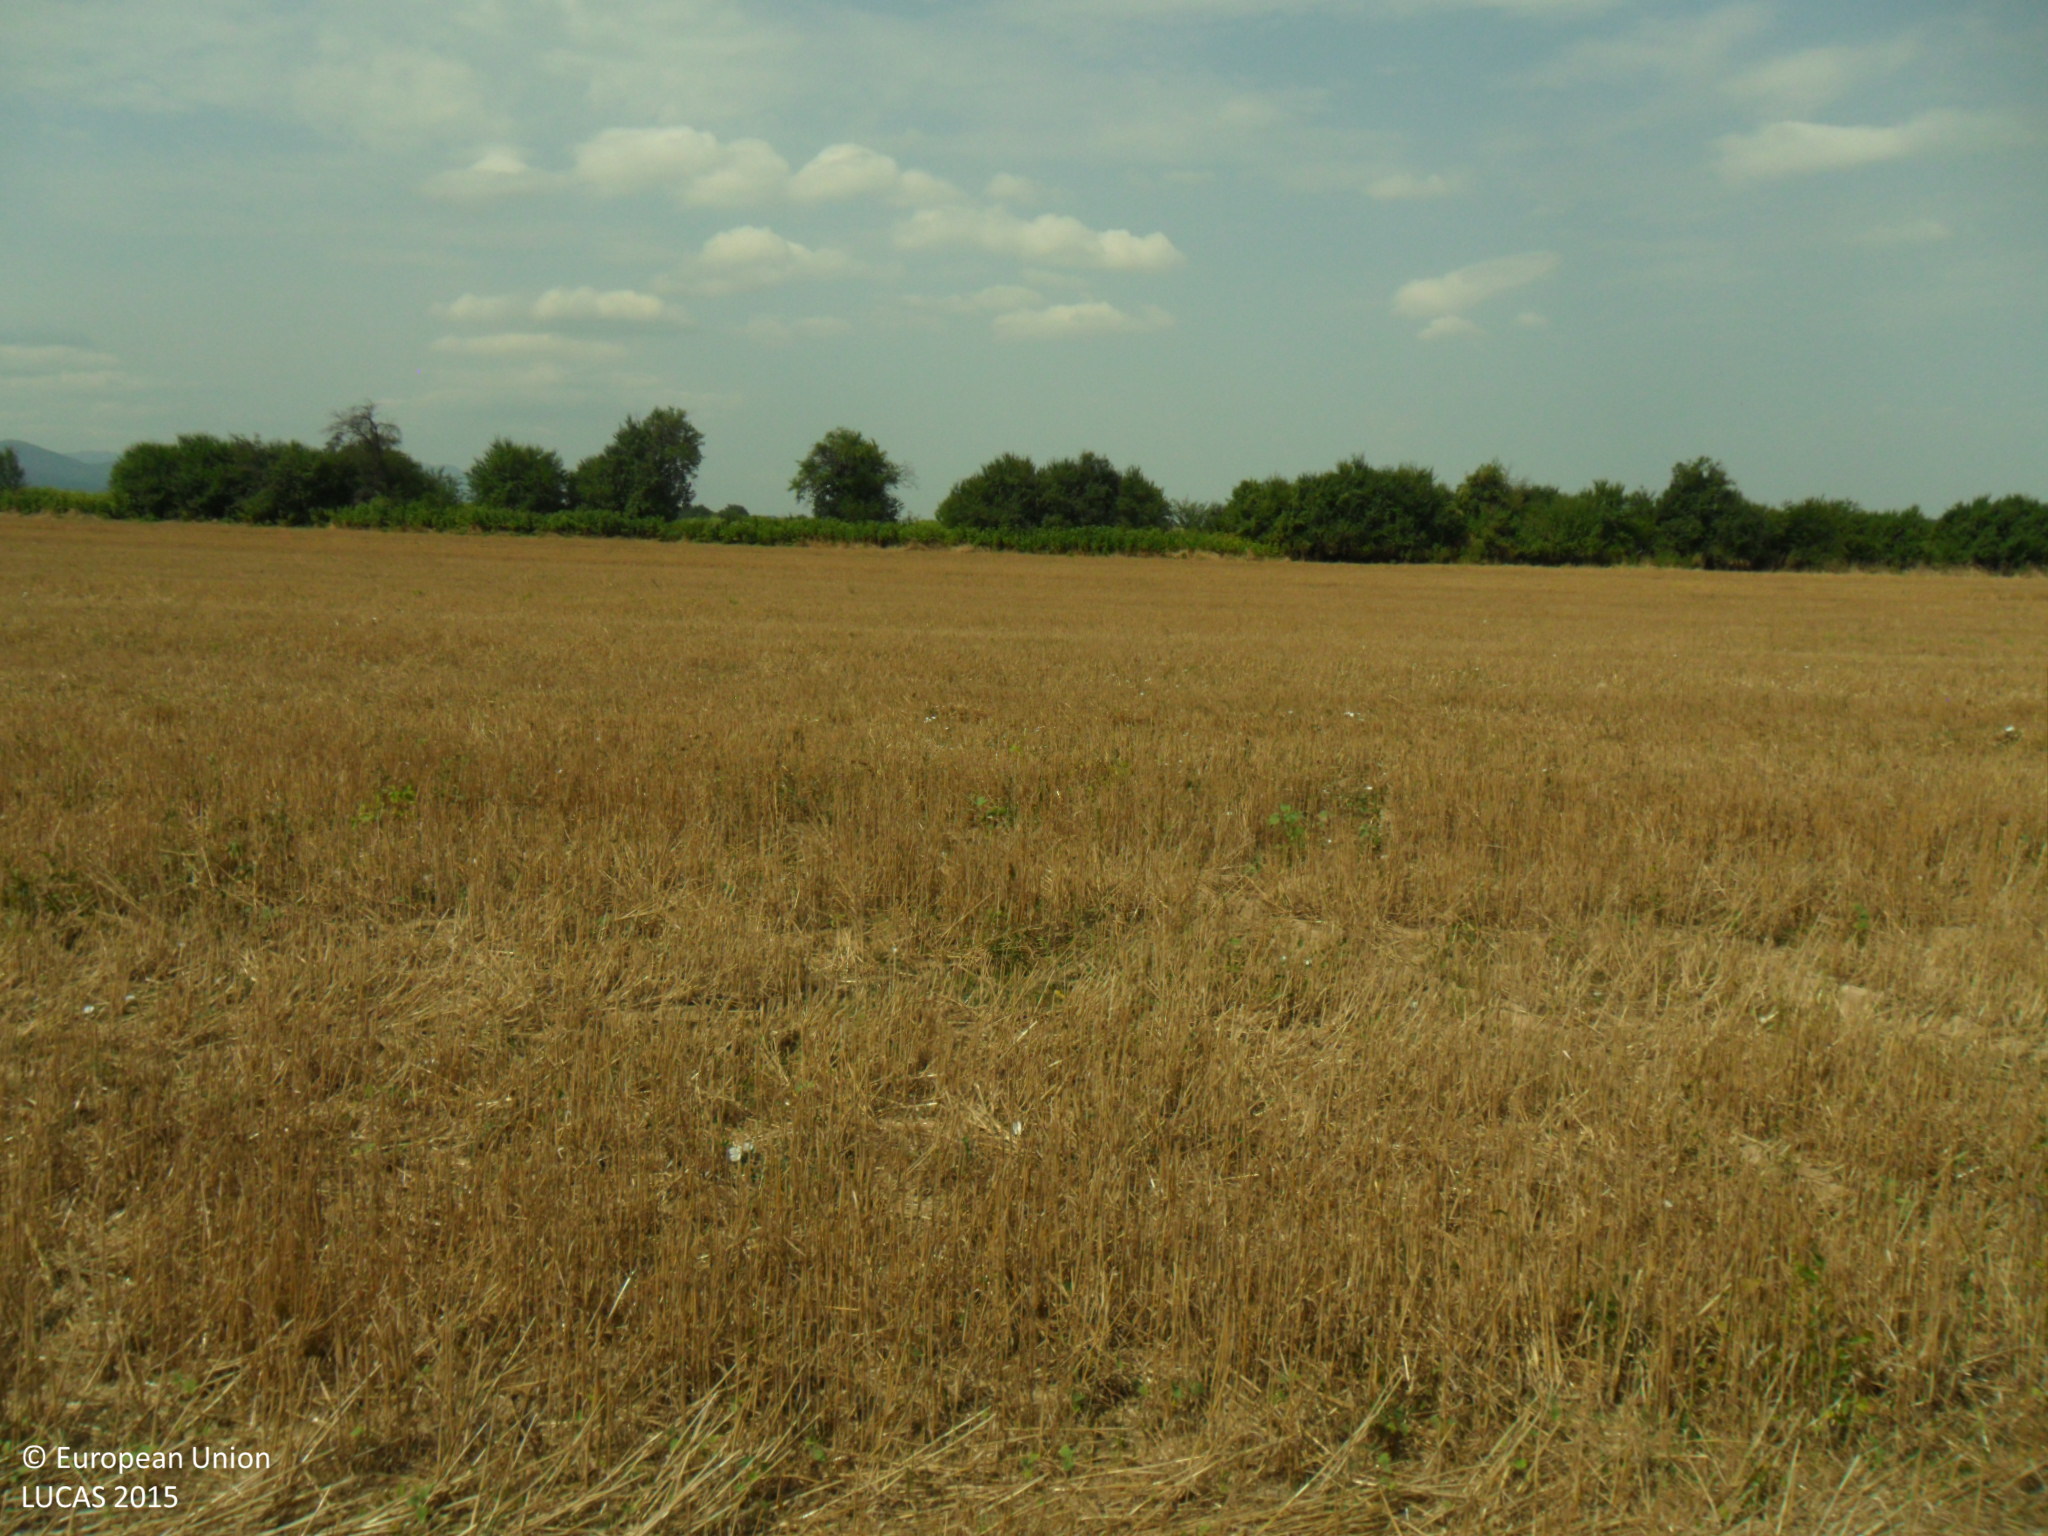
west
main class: Cropland
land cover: Common wheat
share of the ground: > 75 %
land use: Agriculture (excluding fallow land and kitchen gardens)
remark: Harvested field
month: August
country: BG
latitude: 43.0092
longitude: 26.7786
